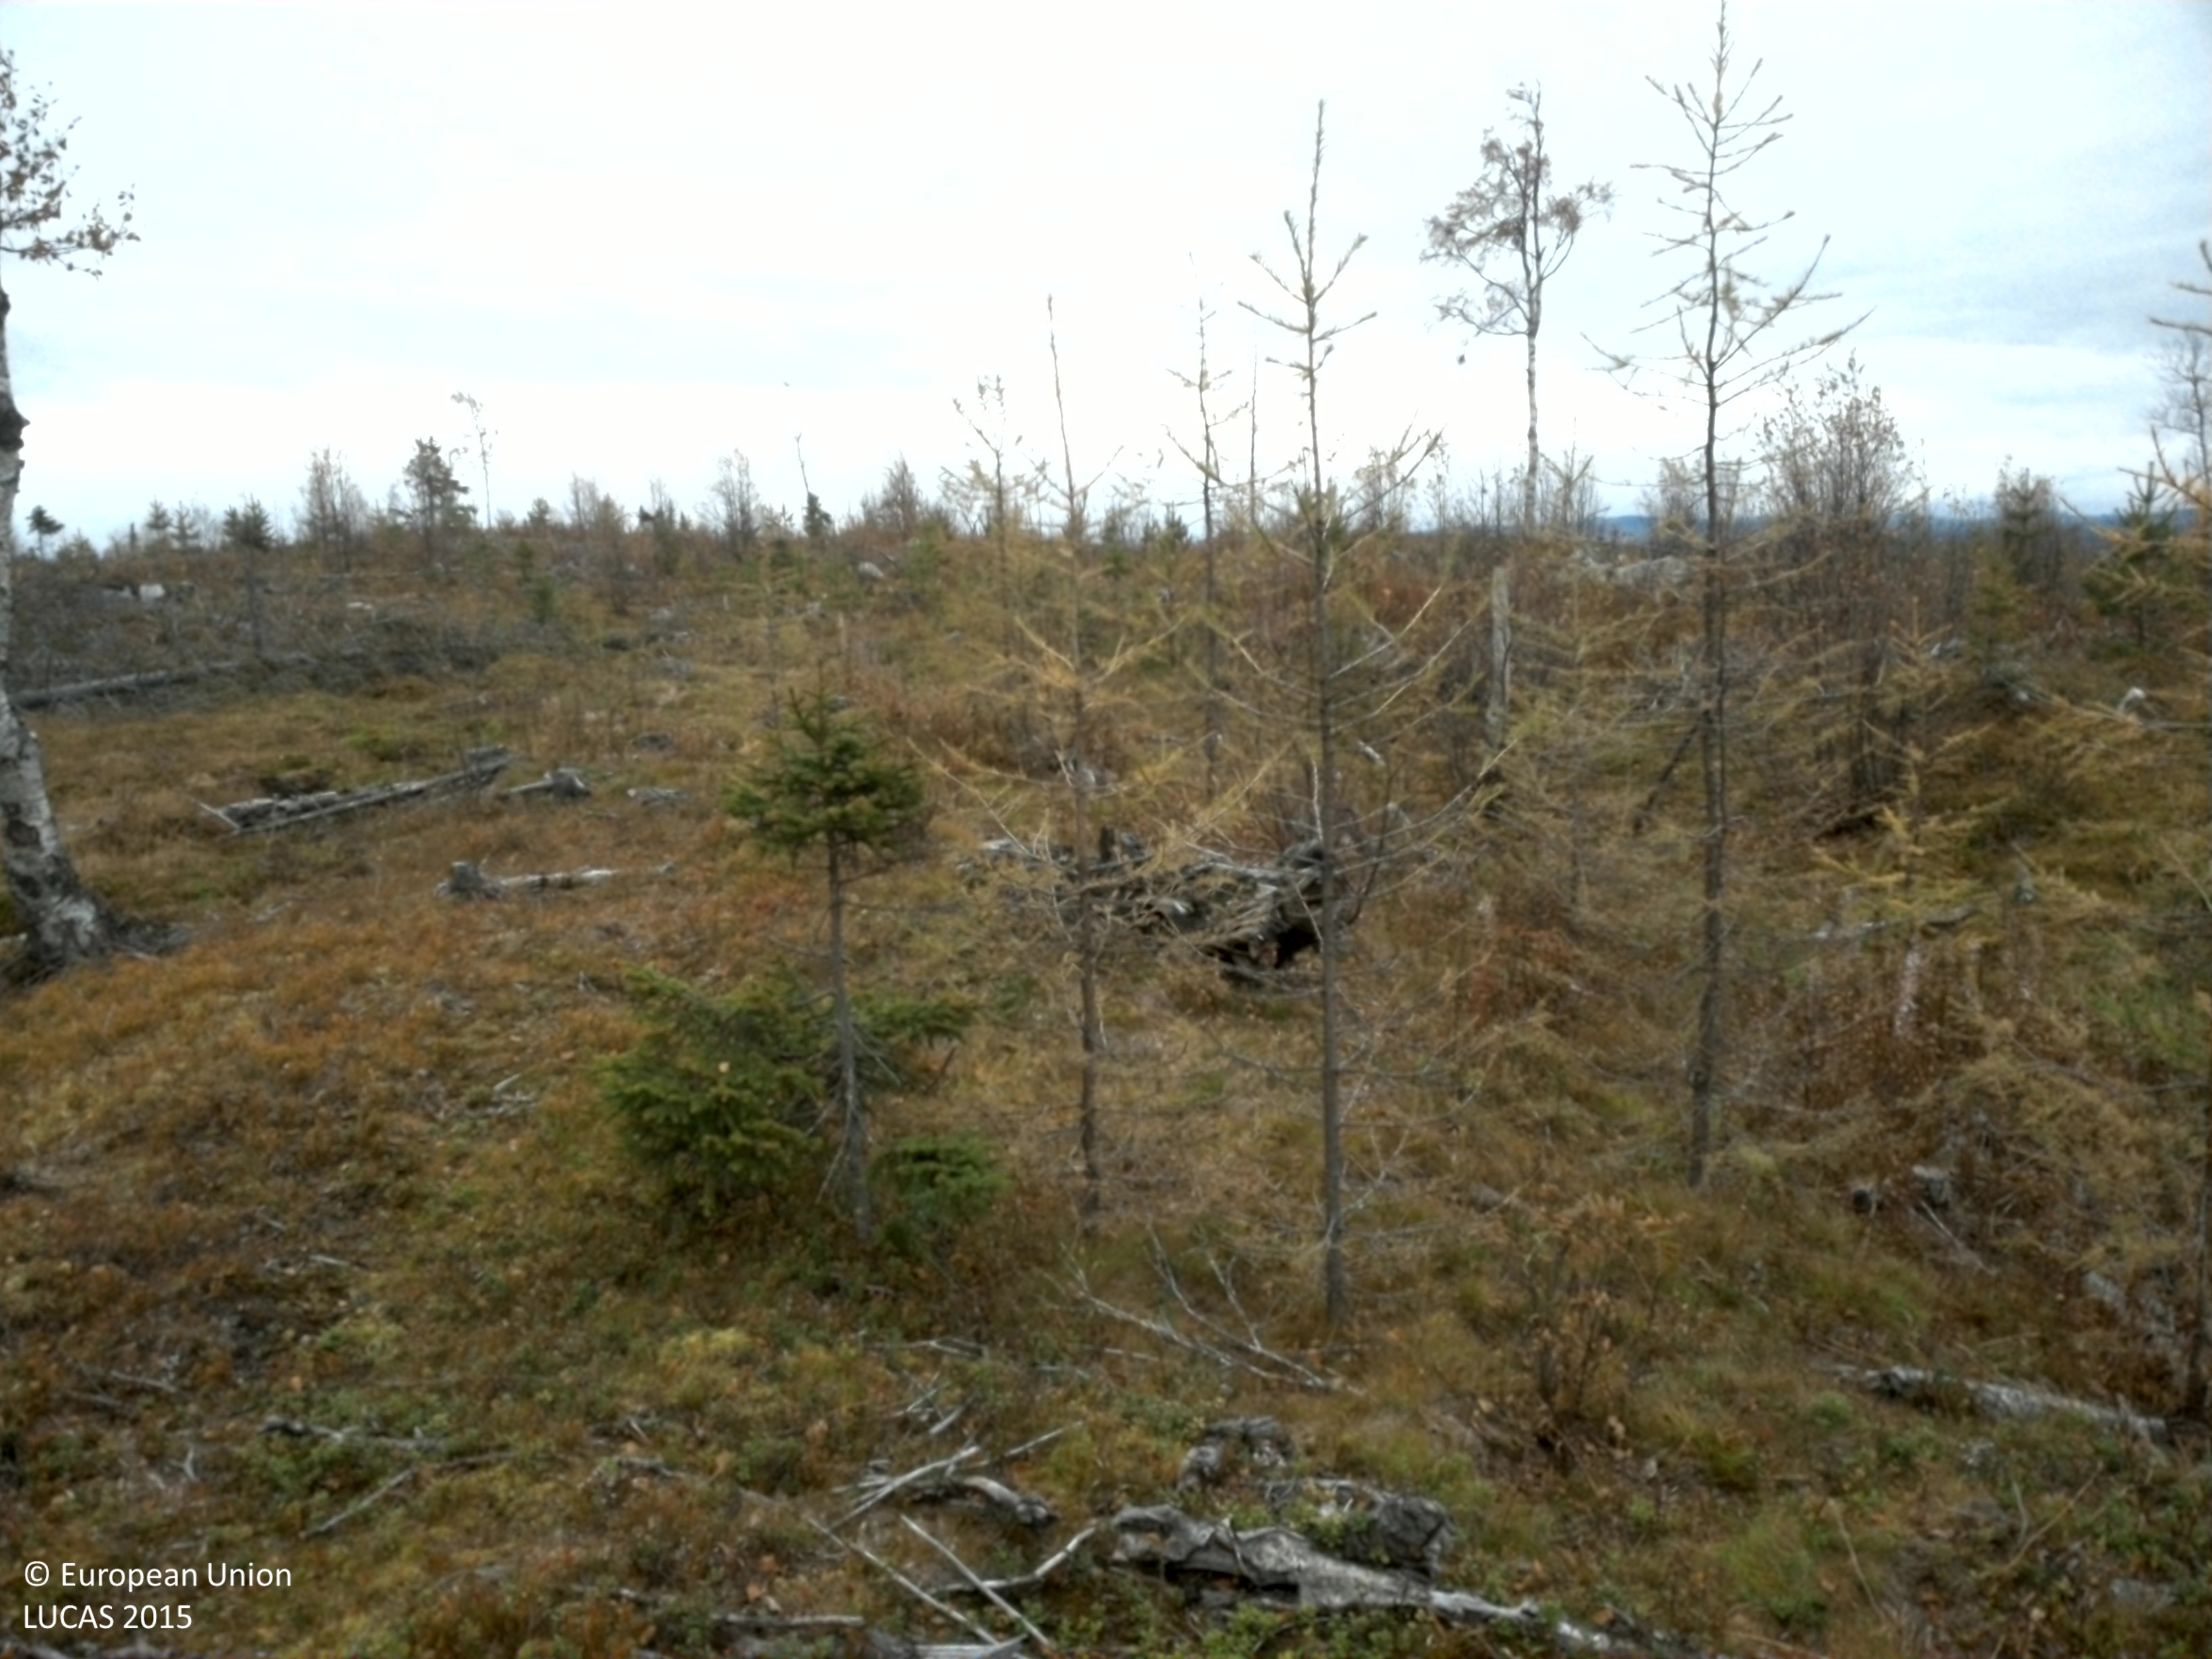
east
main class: Woodland
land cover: Other mixed woodland
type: exotic forest
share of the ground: 10 - 25 %
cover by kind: herbaceous plants 55 %, shrubs 20 %, lichens and mosses 15 %, coniferous forest trees 5 %, broadleaved forest trees 5 %
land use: Forestry
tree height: < 5 m
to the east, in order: Other mixed woodland; Pine dominated mixed woodland; Grassland with sparse tree/shrub cover; Pine dominated mixed woodland; Grassland with sparse tree/shrub cover; Pine dominated mixed woodland
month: October
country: SE
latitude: 64.9560
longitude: 16.8876
